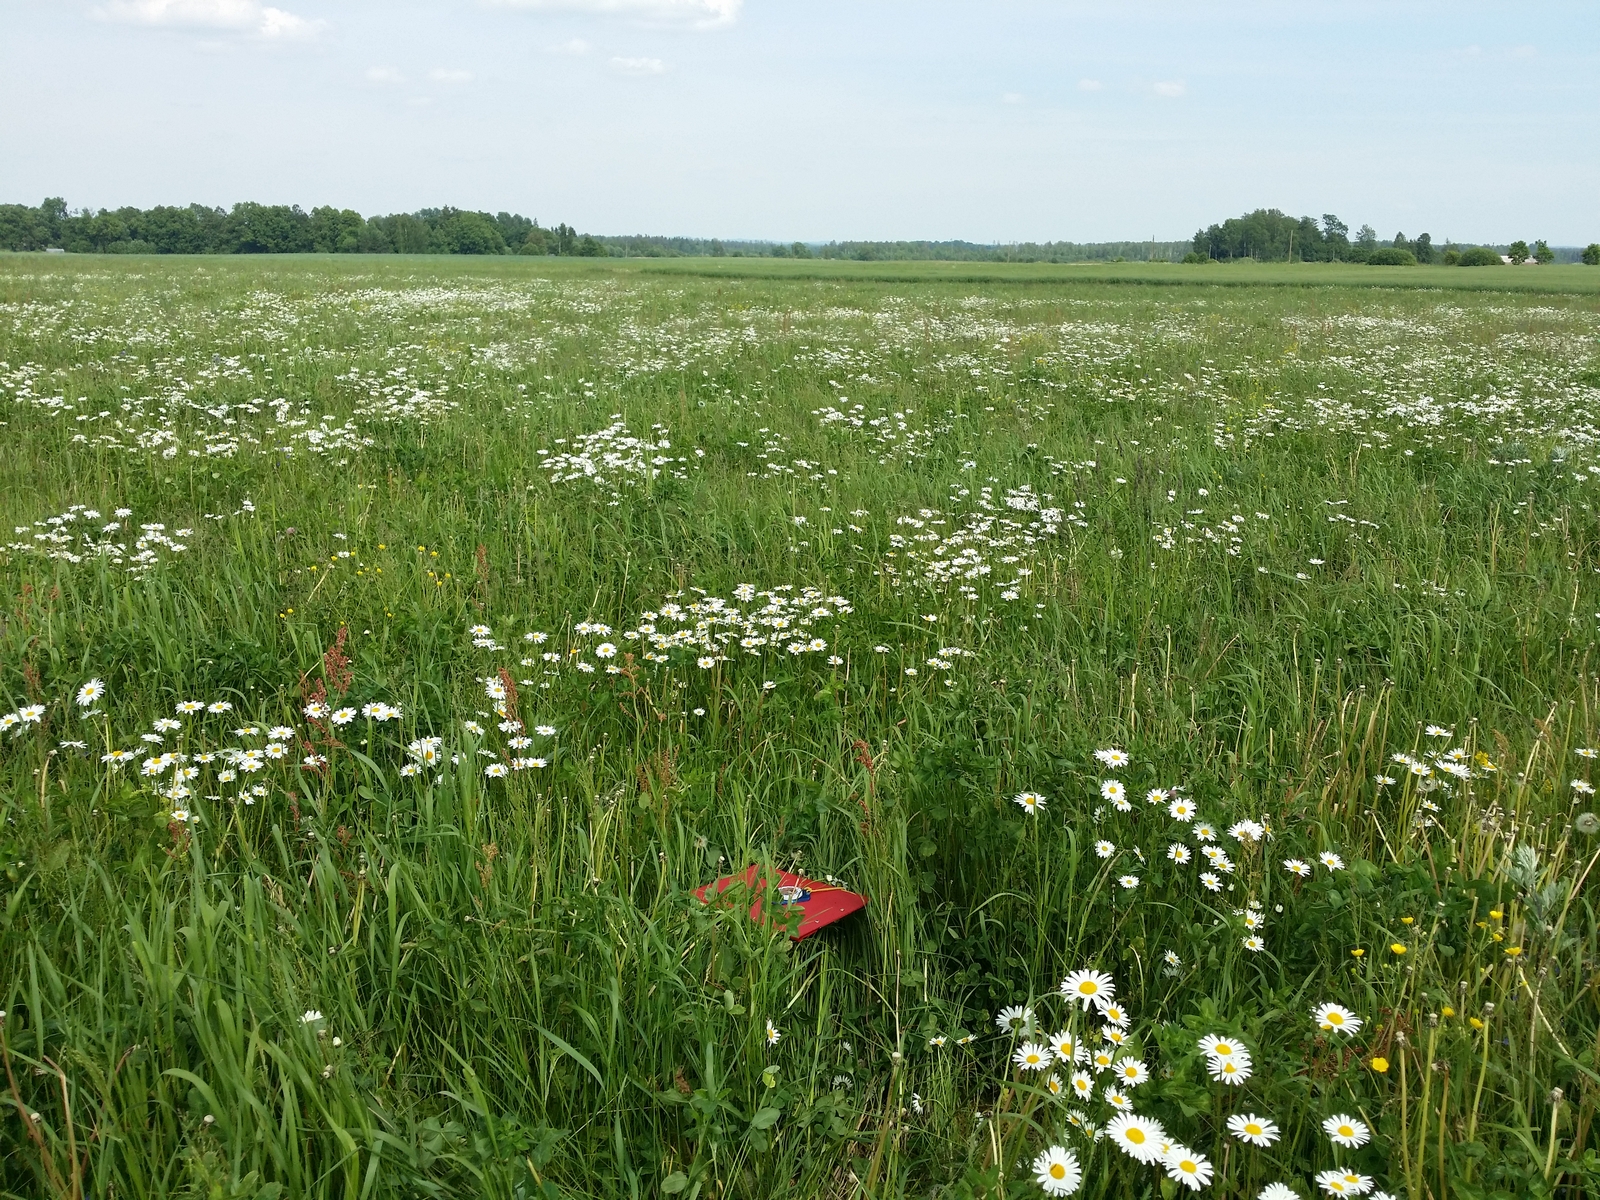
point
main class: Grassland
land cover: Grassland without tree/shrub cover
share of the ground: > 75 %
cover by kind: herbaceous plants 100 %
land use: Agriculture (excluding fallow land and kitchen gardens)
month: June
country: LV
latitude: 57.4354
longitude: 26.5868
